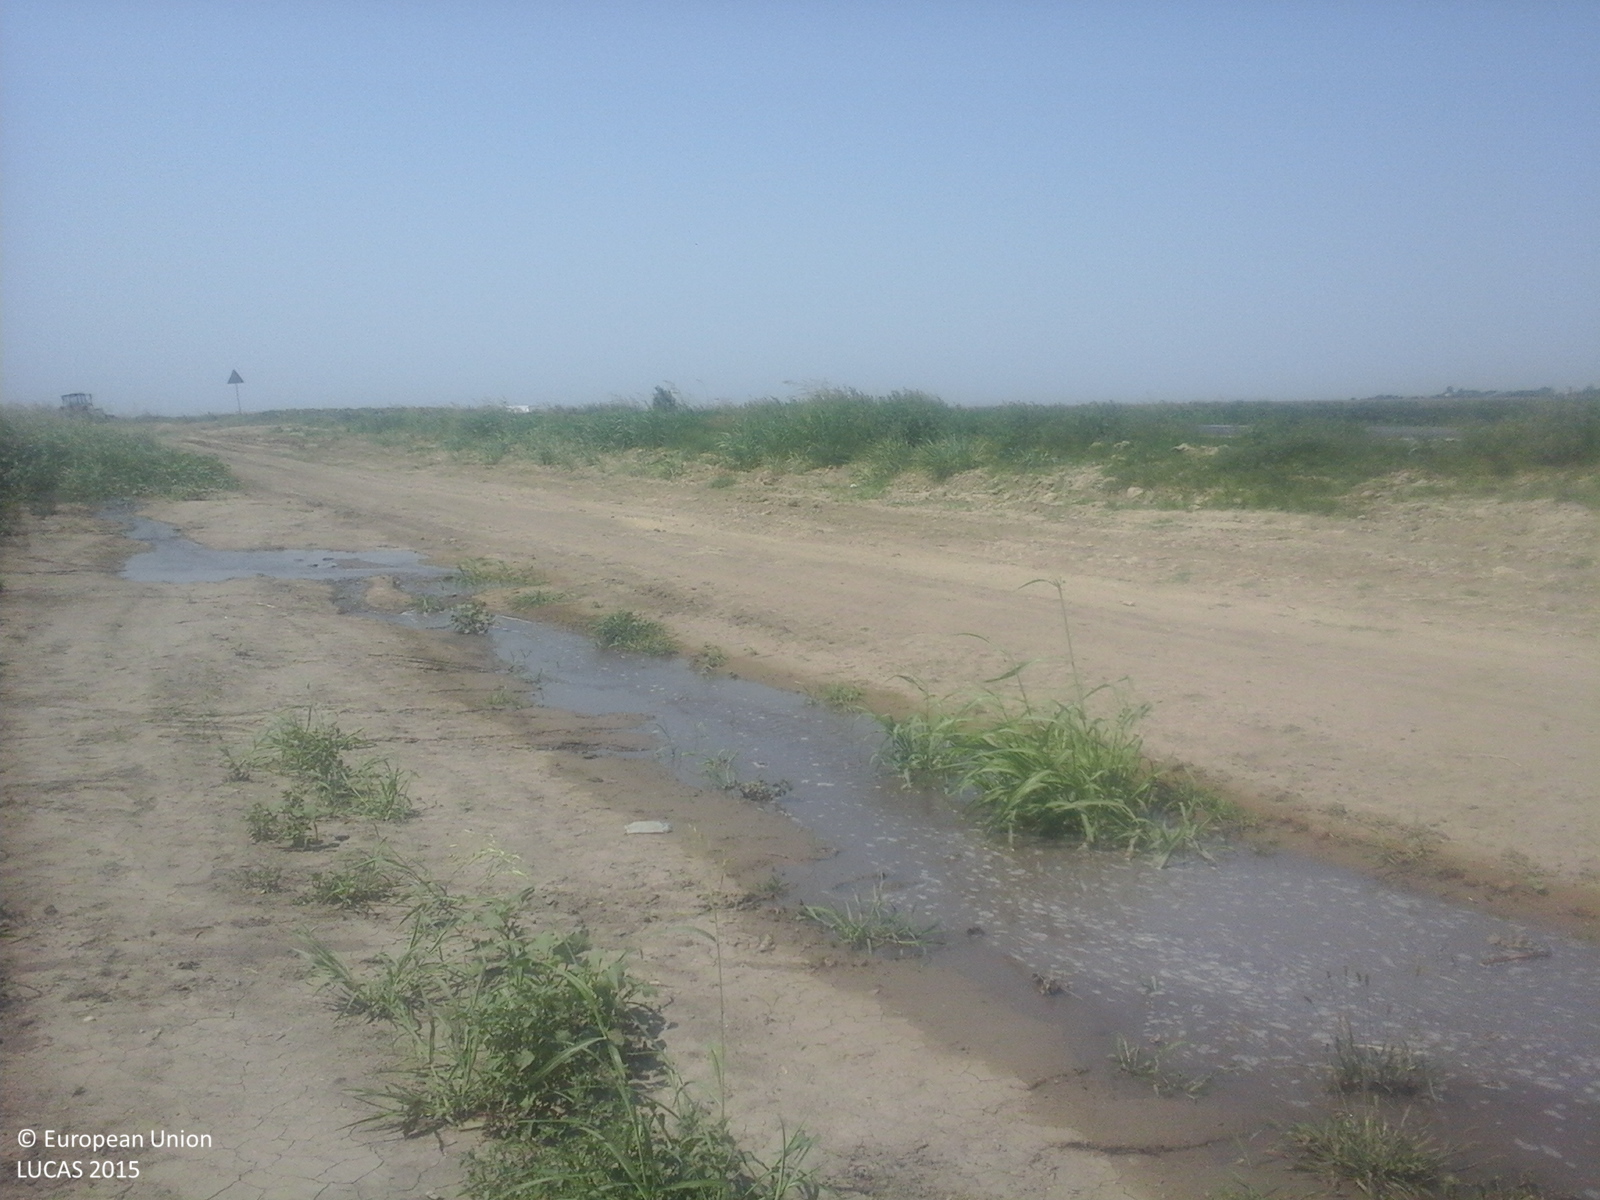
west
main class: Cropland
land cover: Soya
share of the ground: > 75 %
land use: Agriculture (excluding fallow land and kitchen gardens)
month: August
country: RO
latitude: 45.1551
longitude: 27.6971
